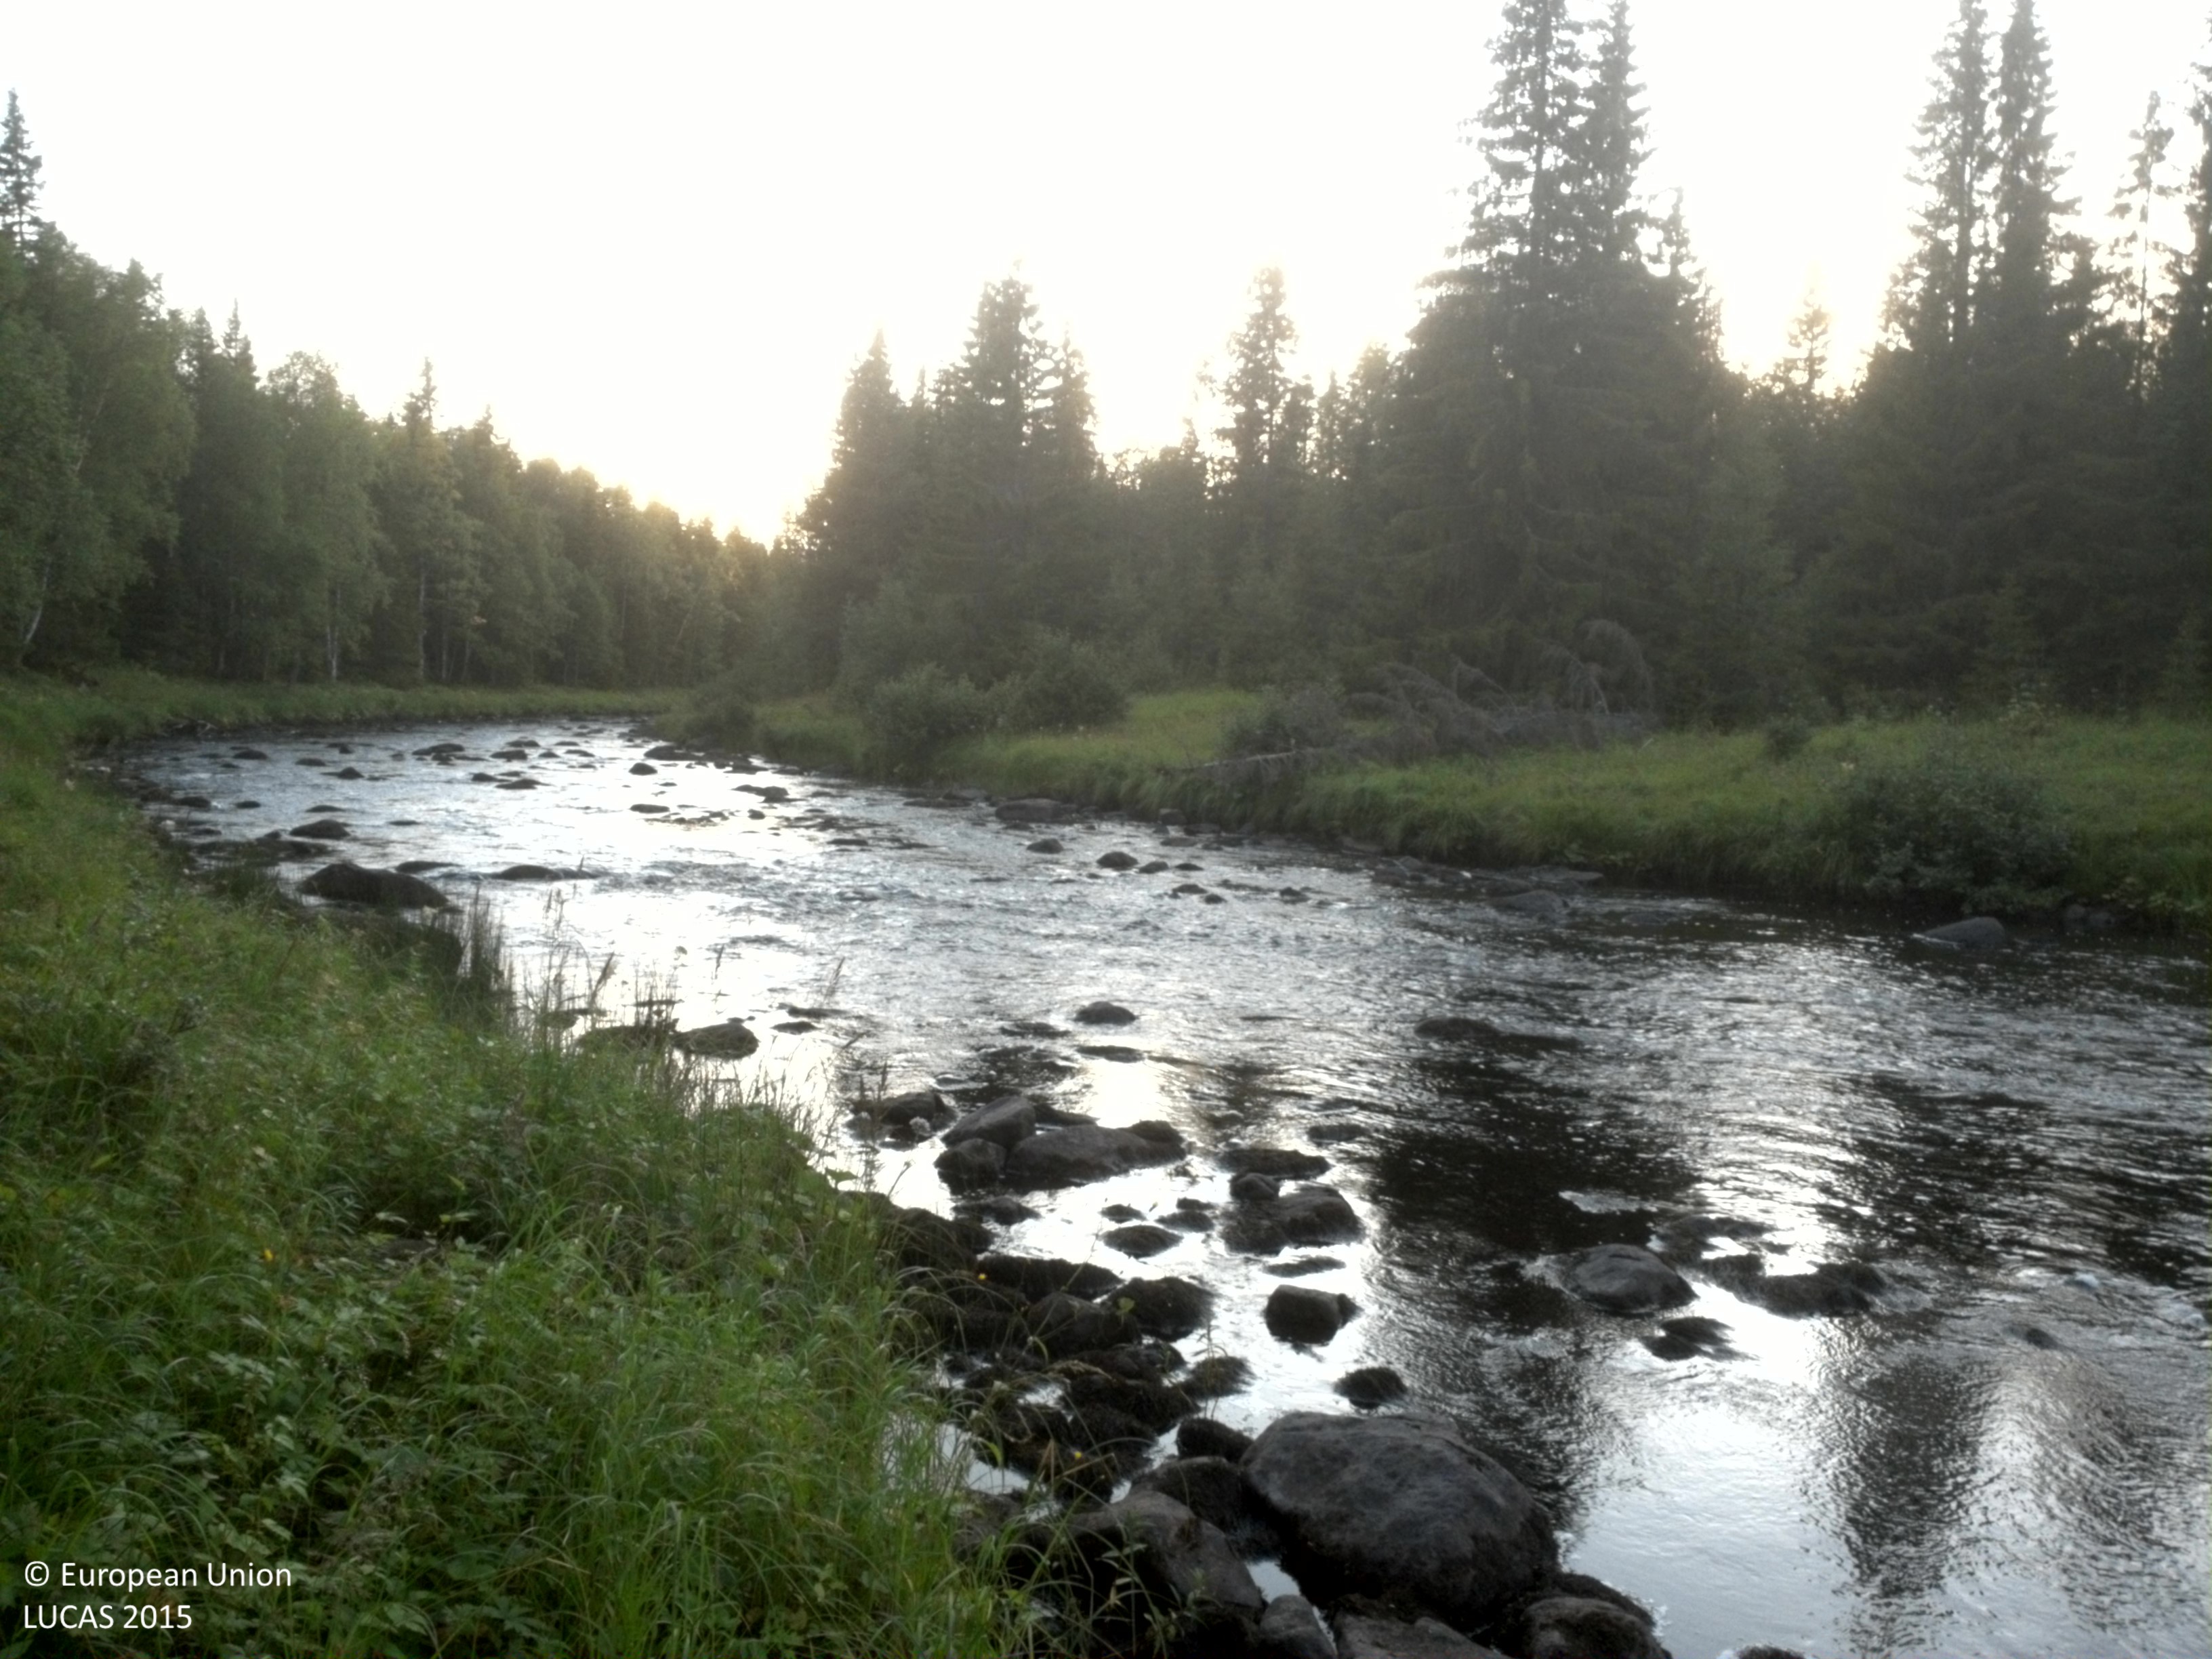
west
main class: Woodland
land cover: Spruce dominated mixed woodland
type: boreal forest
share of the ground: 50 - 75 %
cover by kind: coniferous forest trees 45 %, shrubs 30 %, broadleaved forest trees 15 %, herbaceous plants 10 %
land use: Forestry
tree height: > 5 m
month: August
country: SE
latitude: 64.4554
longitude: 18.2613
